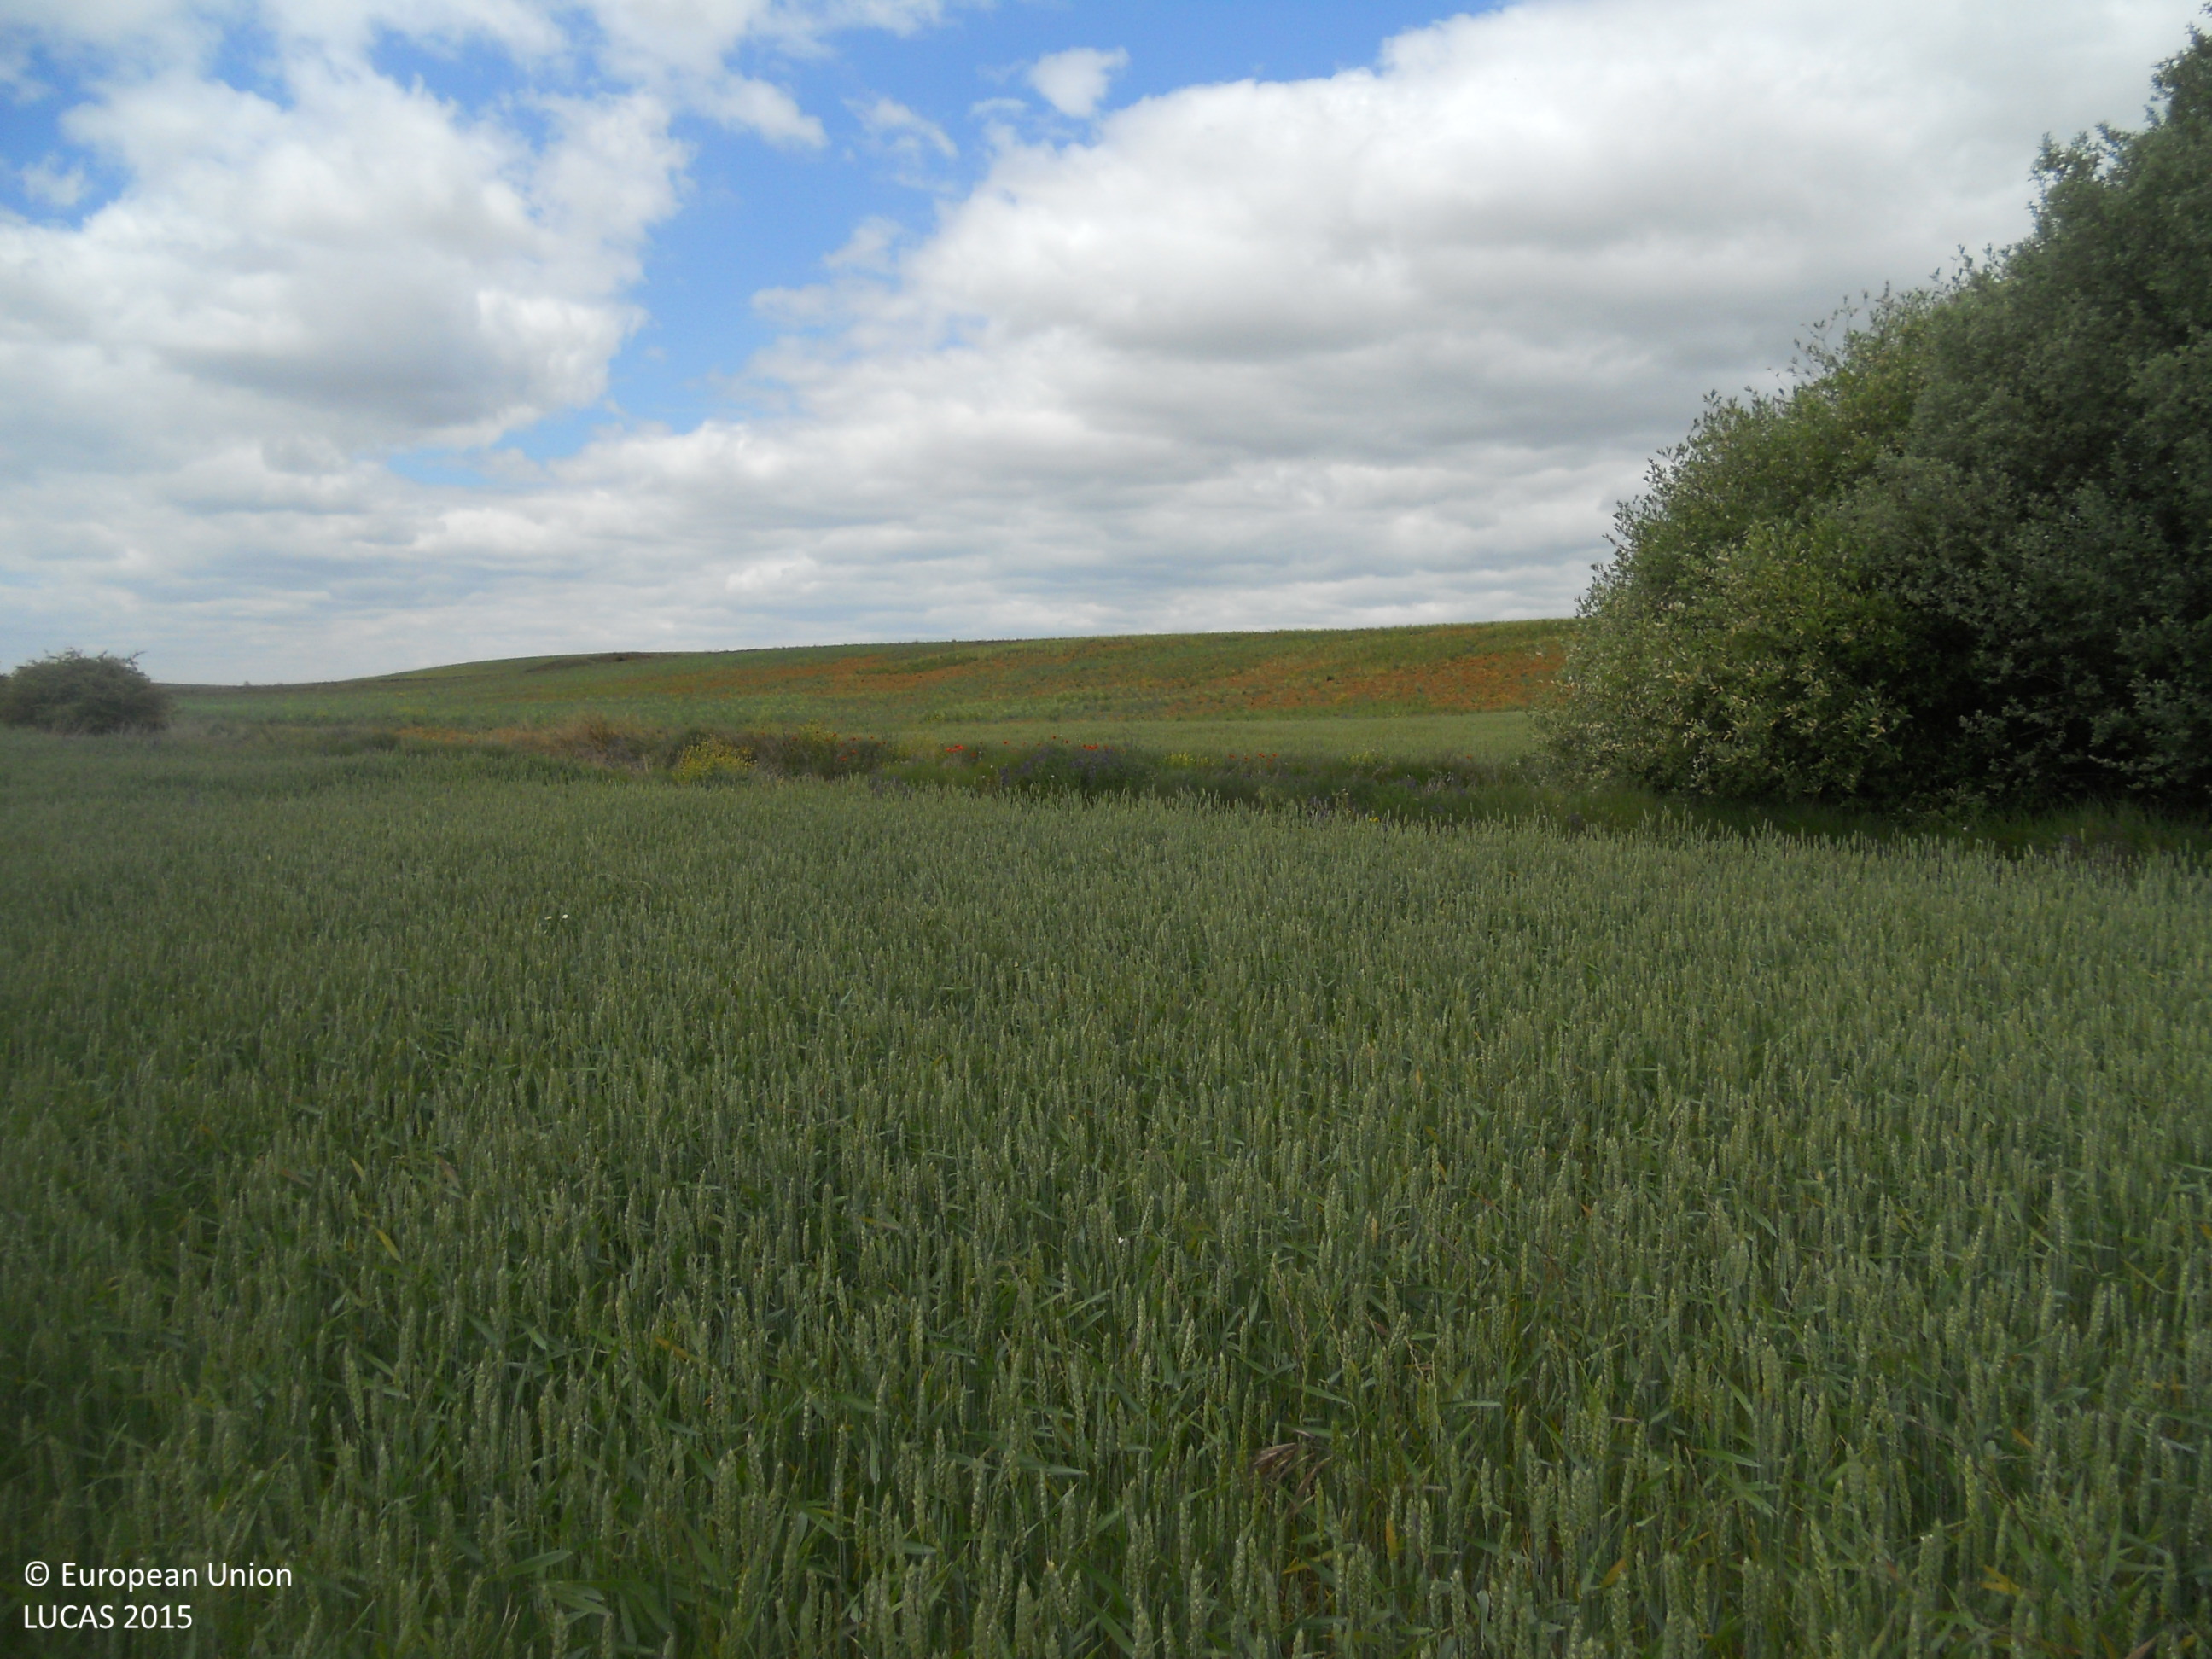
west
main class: Cropland
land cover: Common wheat
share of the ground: > 75 %
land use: Agriculture (excluding fallow land and kitchen gardens)
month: May
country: ES
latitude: 42.3713
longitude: -4.3894
